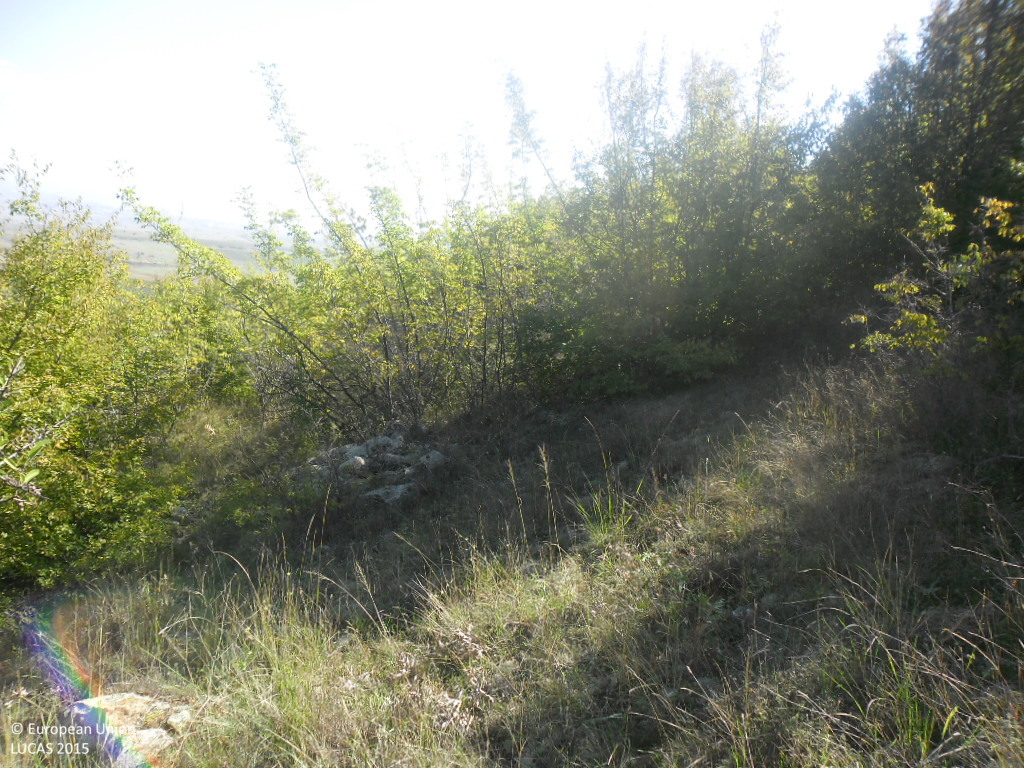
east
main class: Shrubland
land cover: Shrubland with sparse tree cover
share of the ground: 50 - 75 %
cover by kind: shrubs 65 %, herbaceous plants 30 %, broadleaved forest trees 5 %
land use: Agriculture (excluding fallow land and kitchen gardens)
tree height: < 5 m
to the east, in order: Shrubland with sparse tree cover
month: October
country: BG
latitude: 41.4652
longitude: 23.2749
